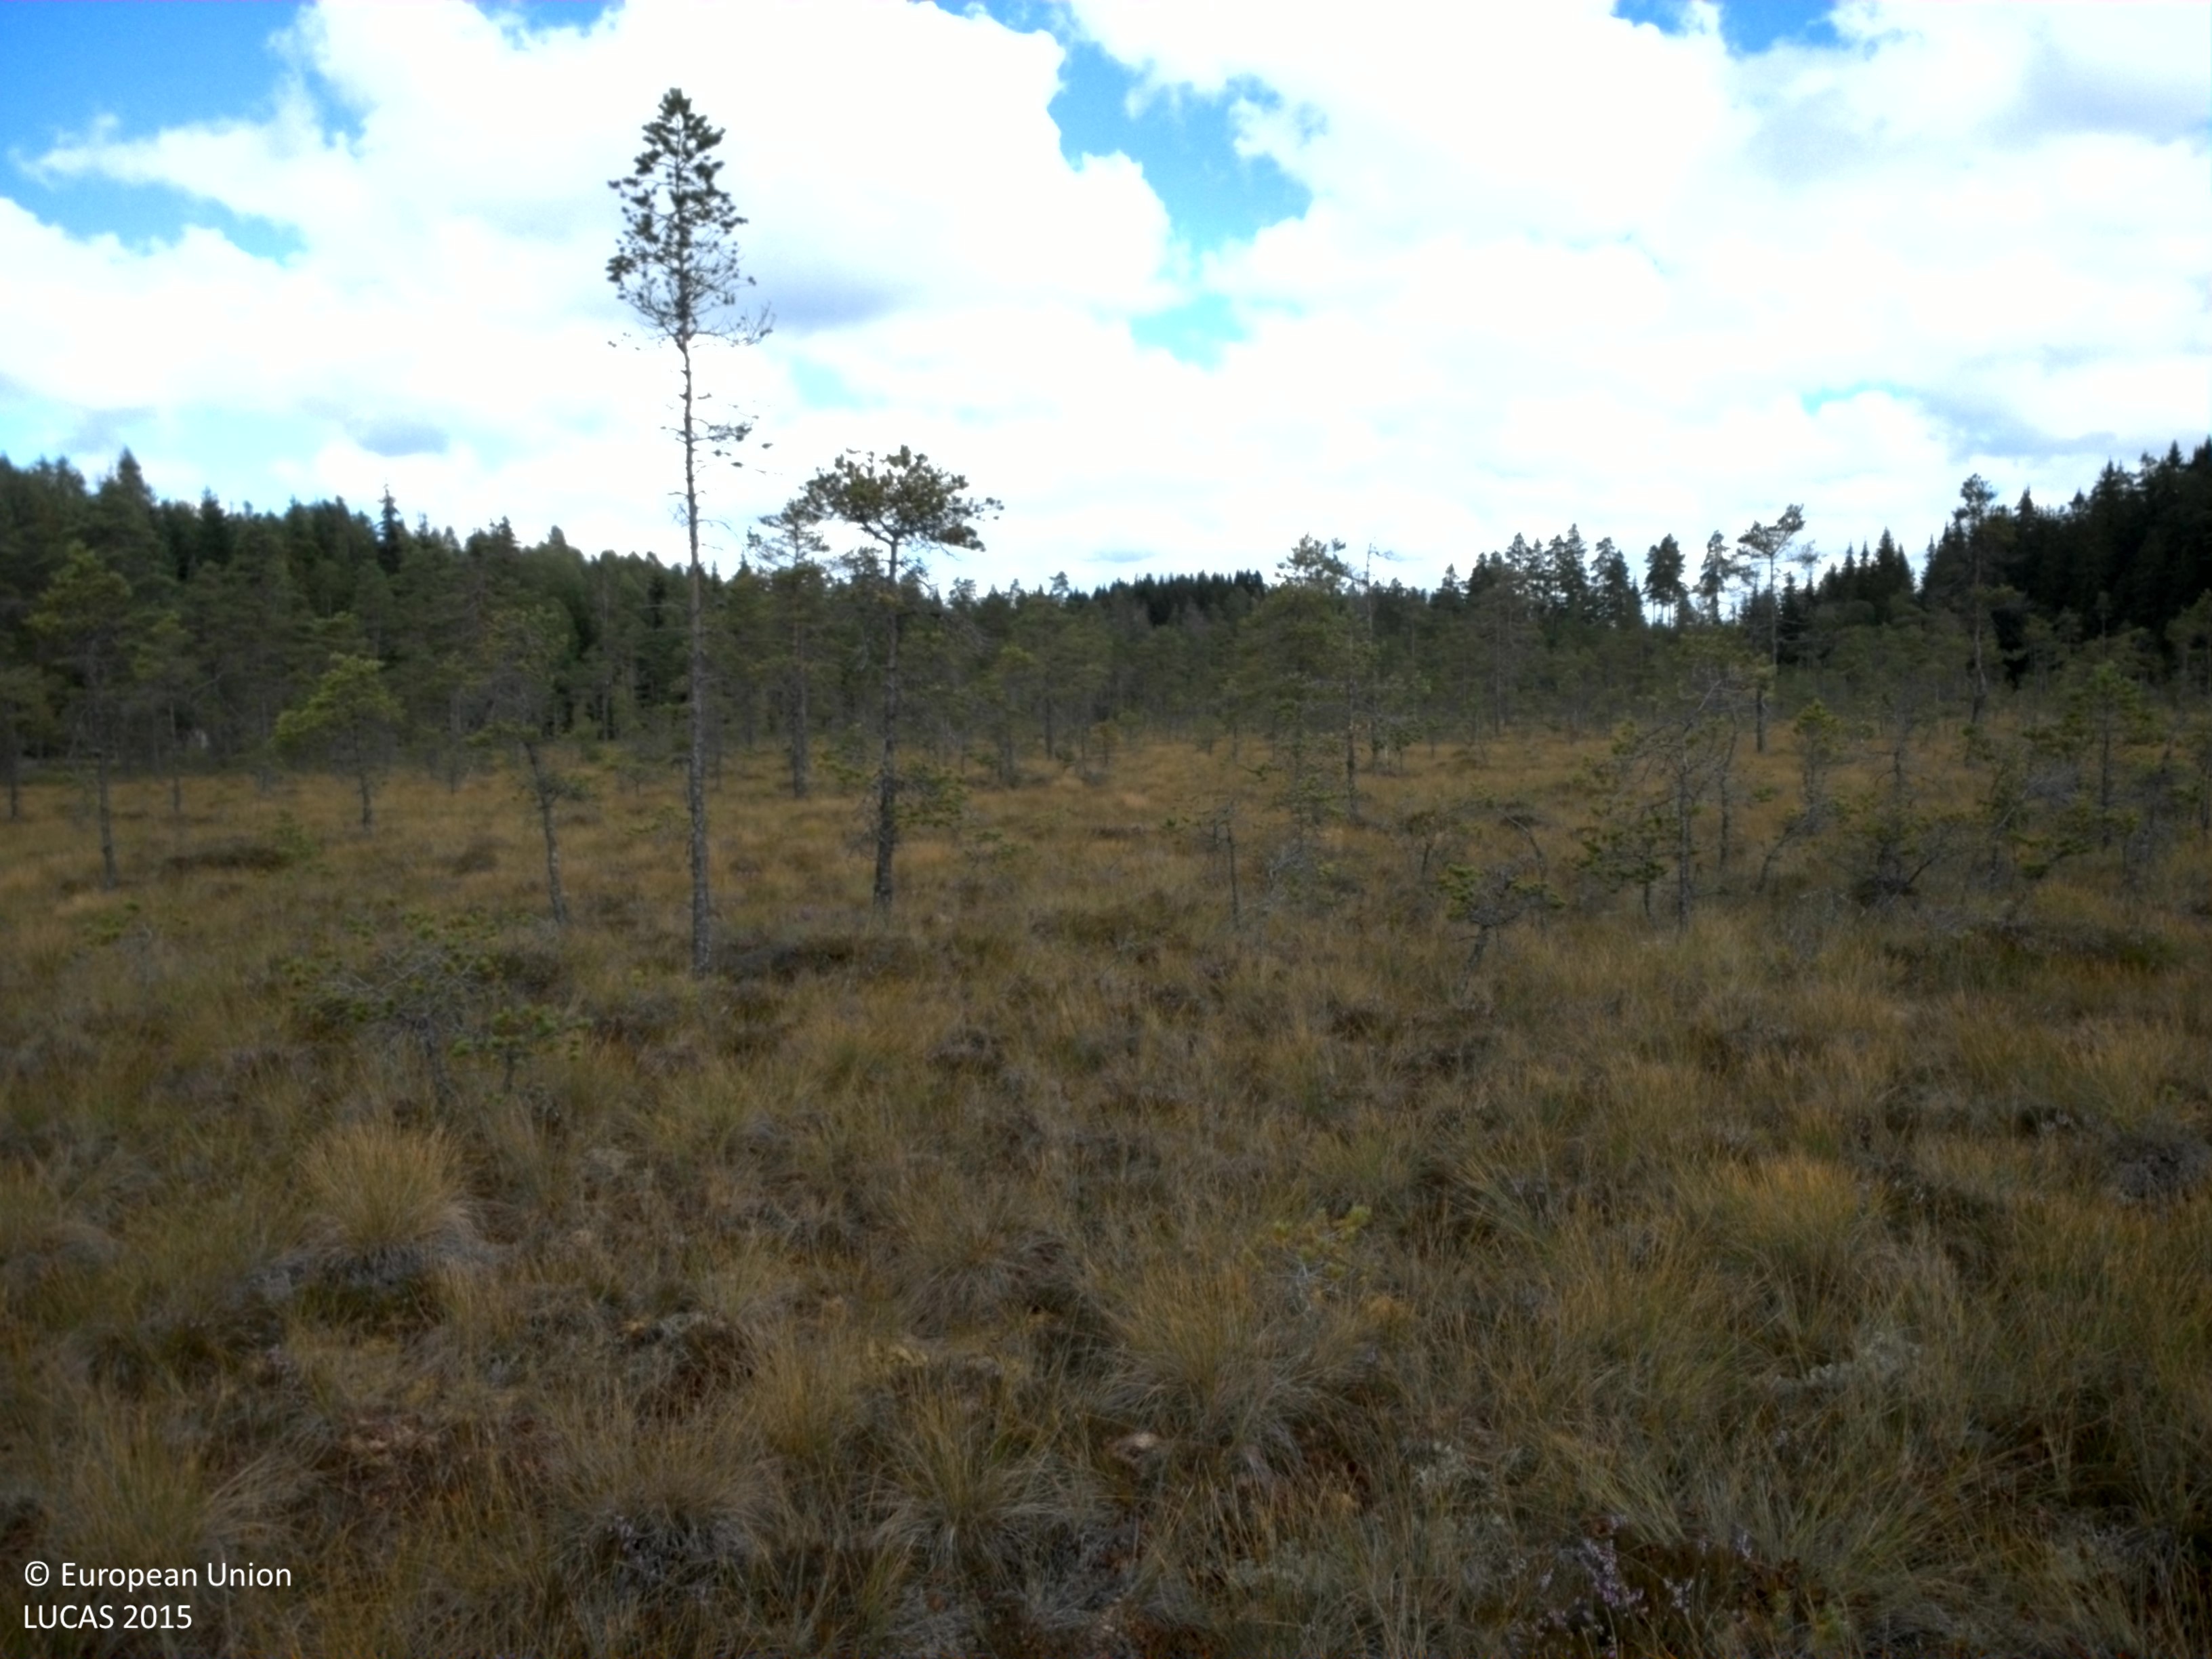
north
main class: Woodland
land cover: Pine dominated coniferous woodland
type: mire and swamp forests
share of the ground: < 10 %
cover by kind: lichens and mosses 40 %, herbaceous plants 30 %, shrubs 20 %, coniferous forest trees 10 %
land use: Semi-natural and natural areas not in use
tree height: < 5 m
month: August
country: SE
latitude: 59.4465
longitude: 11.9877
